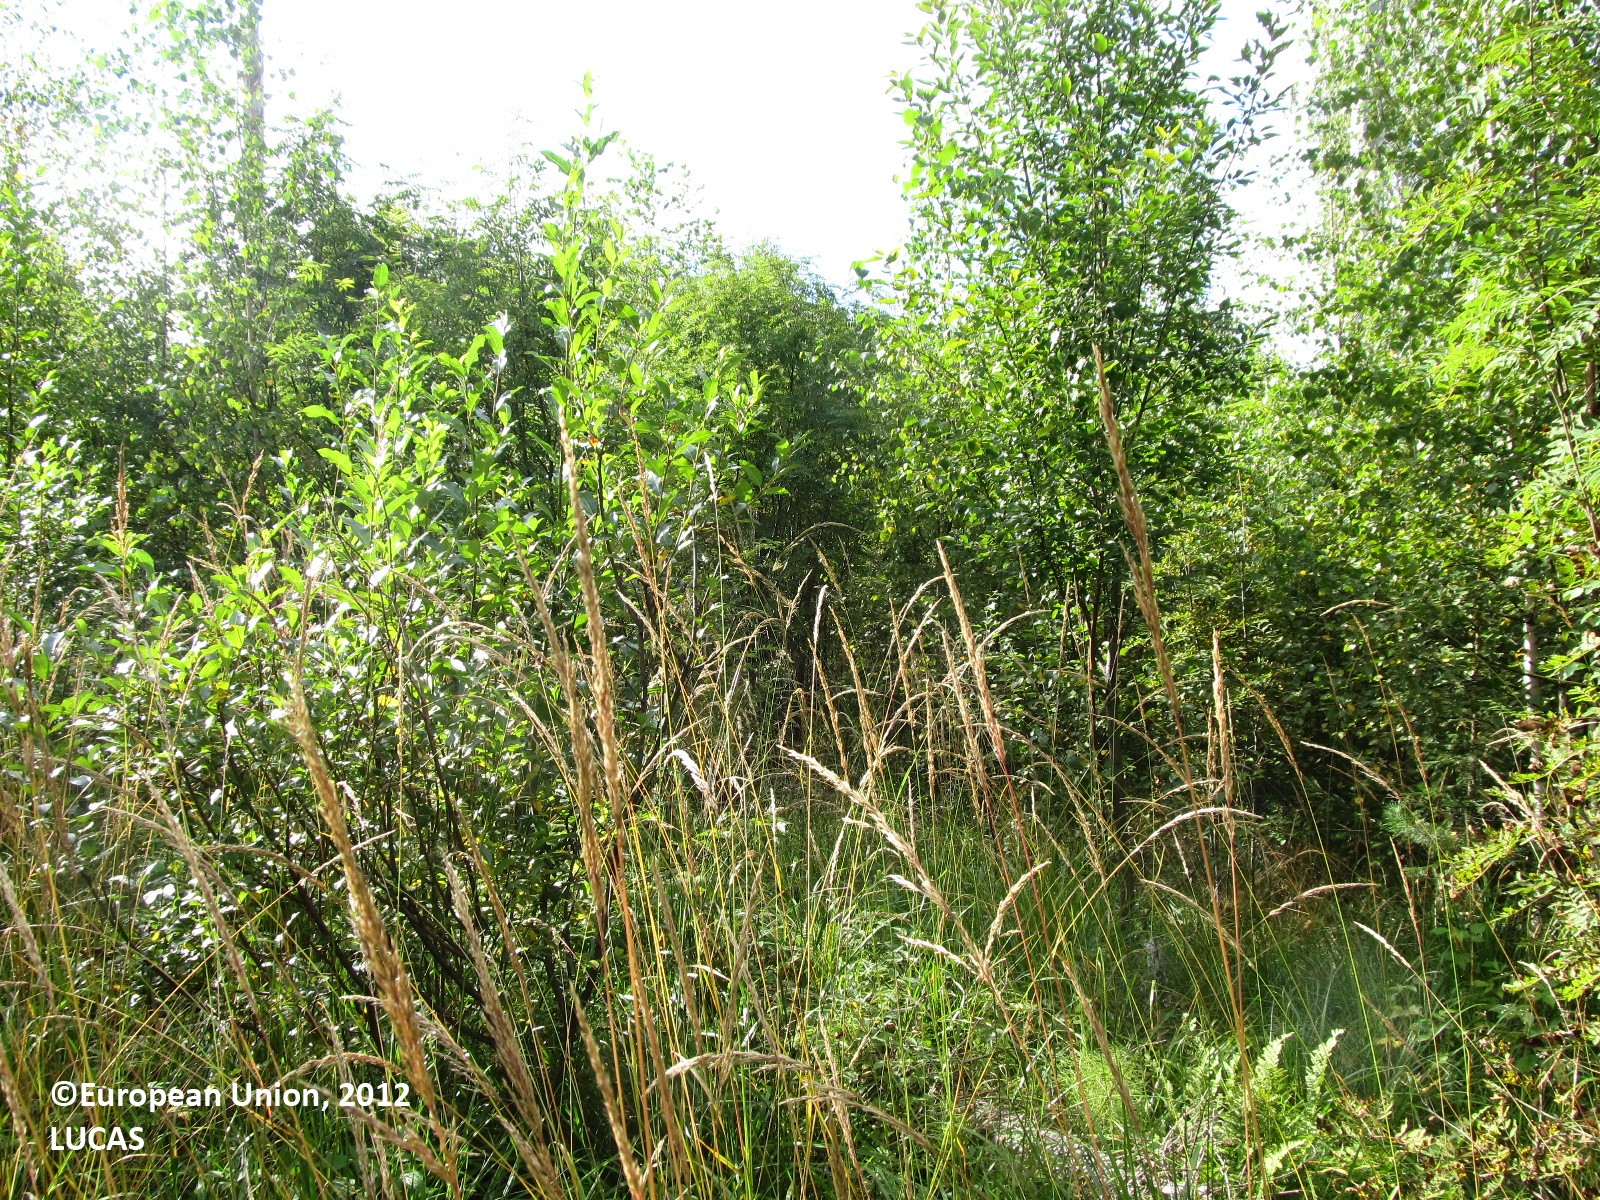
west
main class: Woodland
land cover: Broadleaved woodland
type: boreal forest
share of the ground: 50 - 75 %
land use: Forestry
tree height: < 5 m
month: August
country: FI
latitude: 62.0150
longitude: 27.5384
